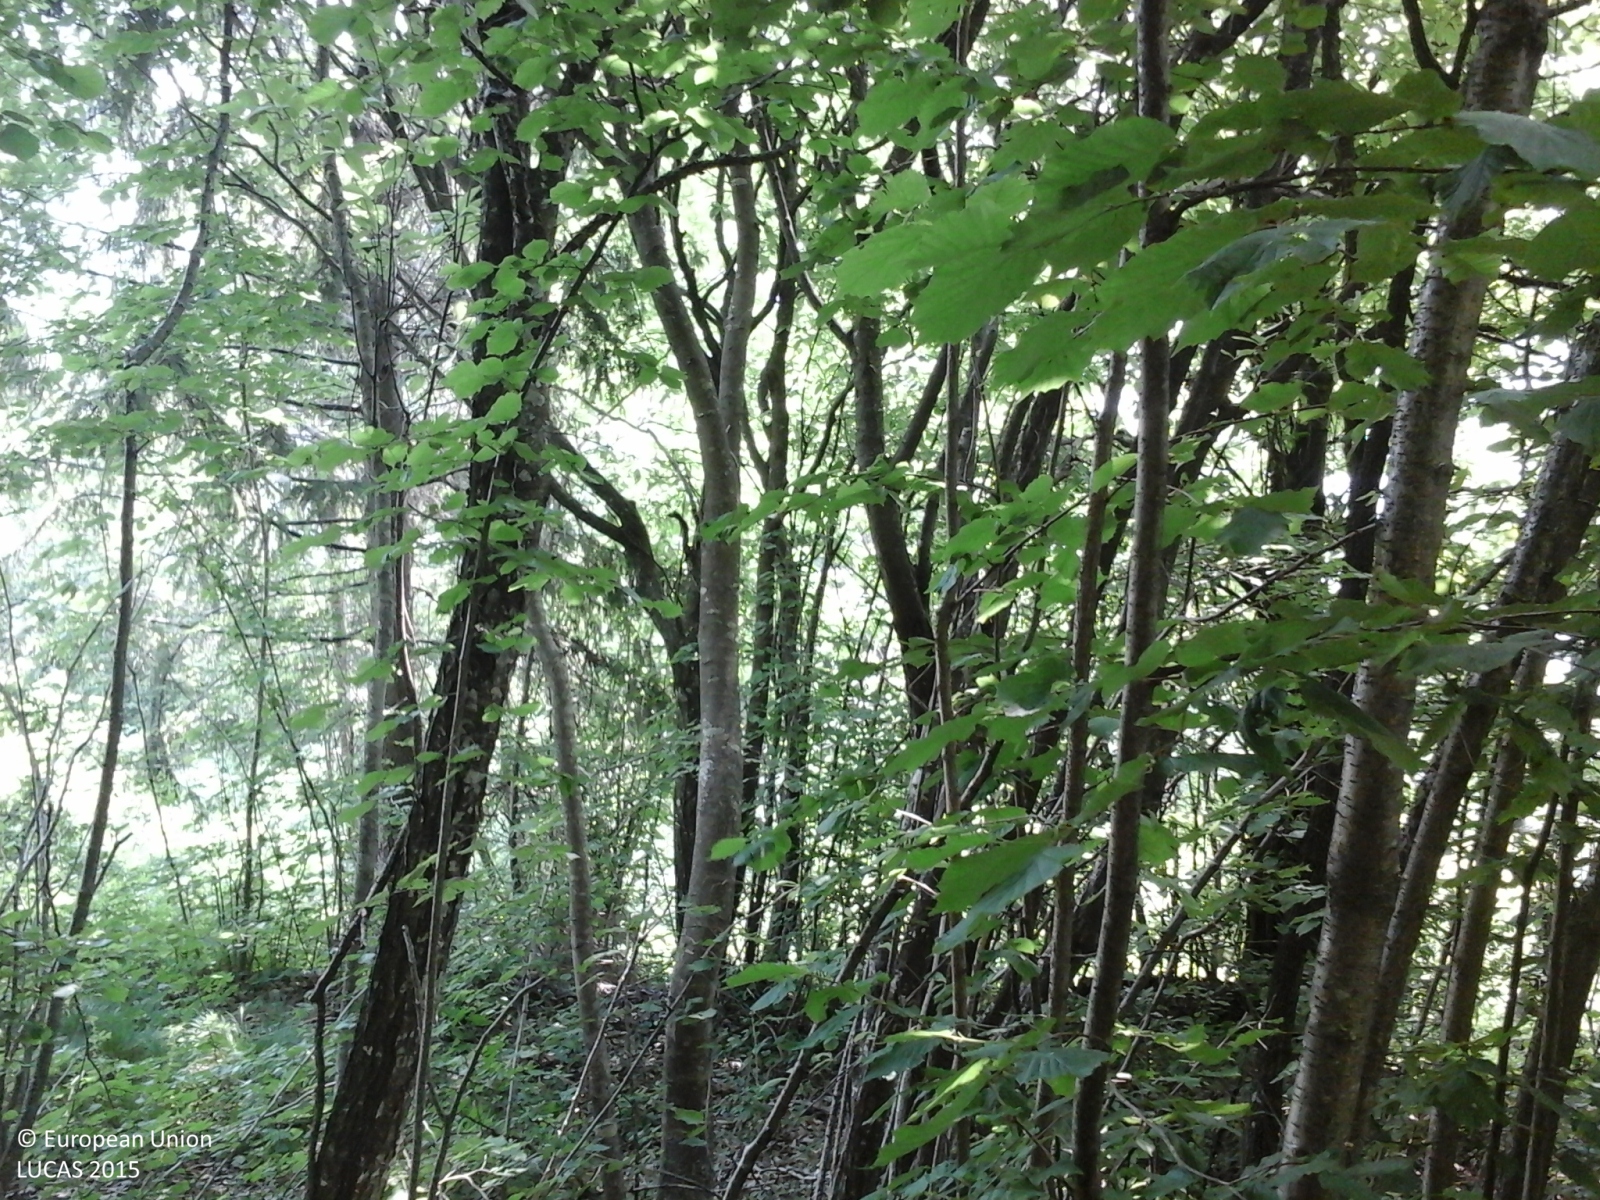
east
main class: Woodland
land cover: Broadleaved woodland
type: thermophilous deciduous forest
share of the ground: > 75 %
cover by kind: broadleaved forest trees 100 %
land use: Forestry
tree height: > 5 m
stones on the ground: 10 - 25 %
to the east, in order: Broadleaved woodland; Paved roads, cycling and walking lanes; Electric lines; Grassland without tree/shrub cover; Broadleaved woodland
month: June
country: IT
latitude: 45.7195
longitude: 10.5002
